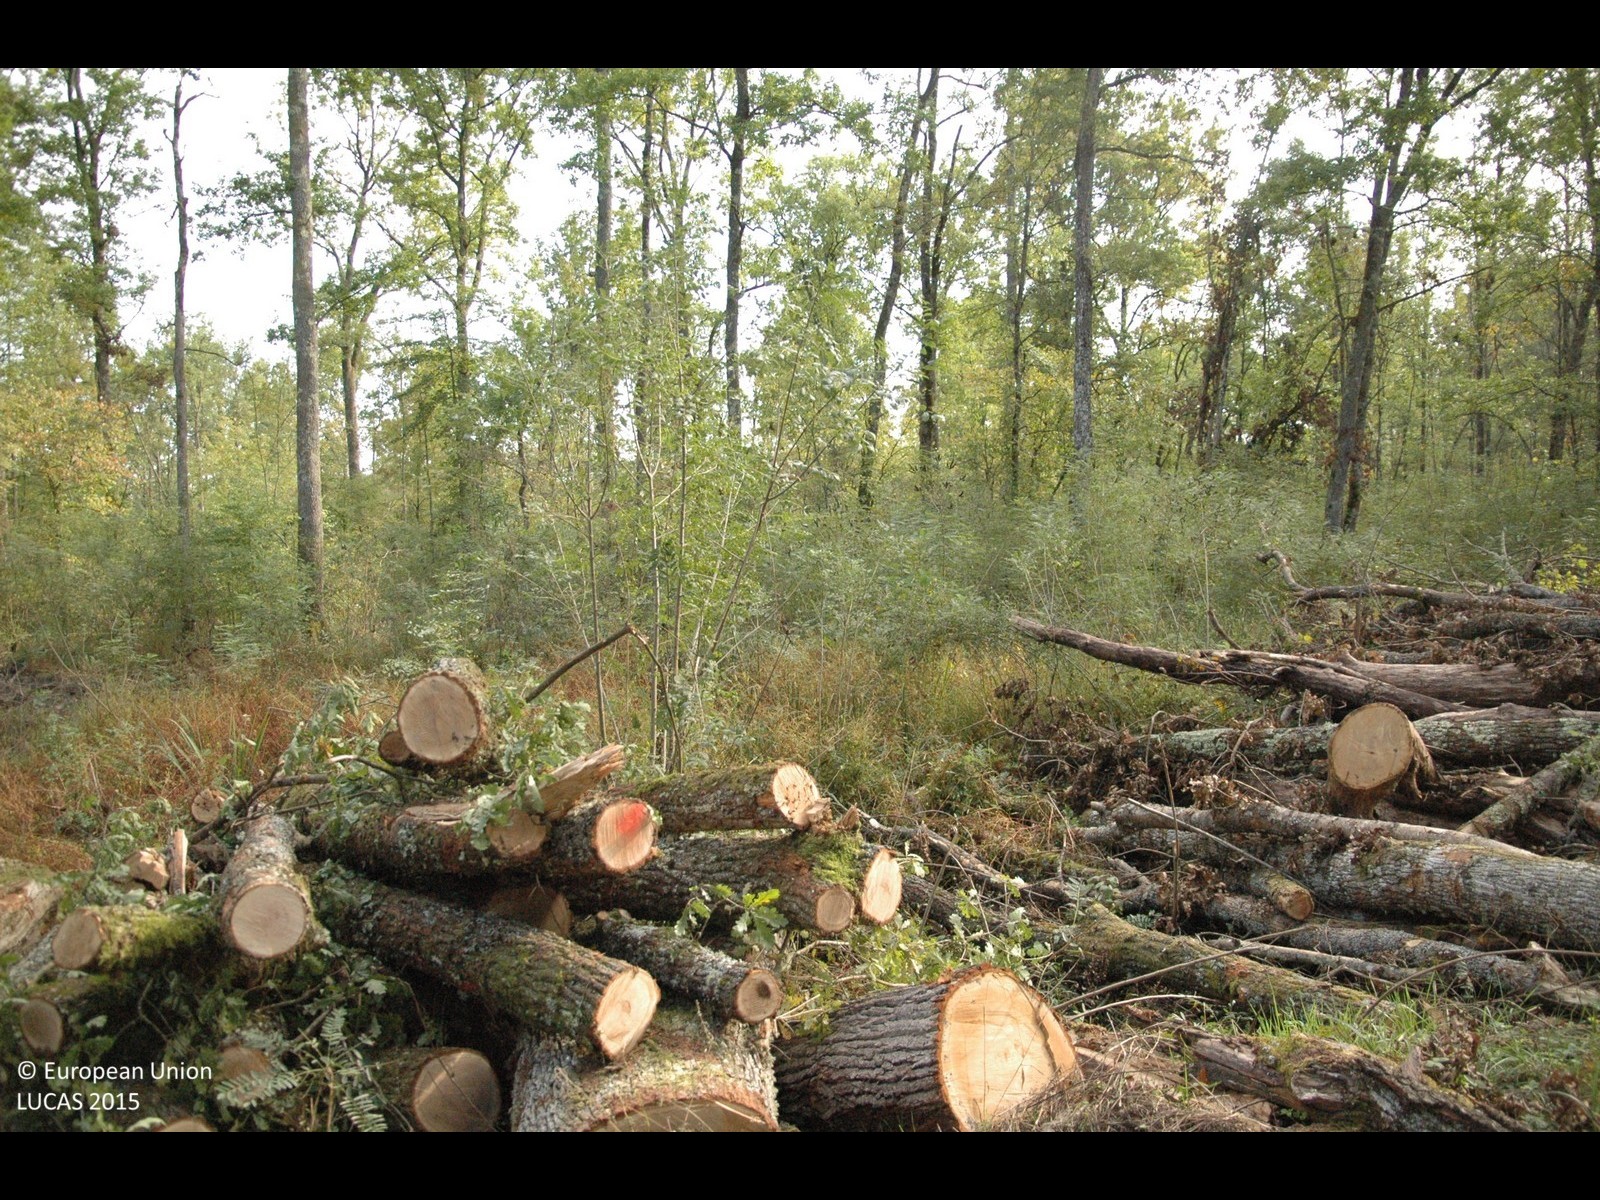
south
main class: Woodland
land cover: Broadleaved woodland
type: floodplain forest
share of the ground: > 75 %
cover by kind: broadleaved forest trees 100 %
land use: Forestry
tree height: > 5 m
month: October
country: HR
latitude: 45.5878
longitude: 16.2914
